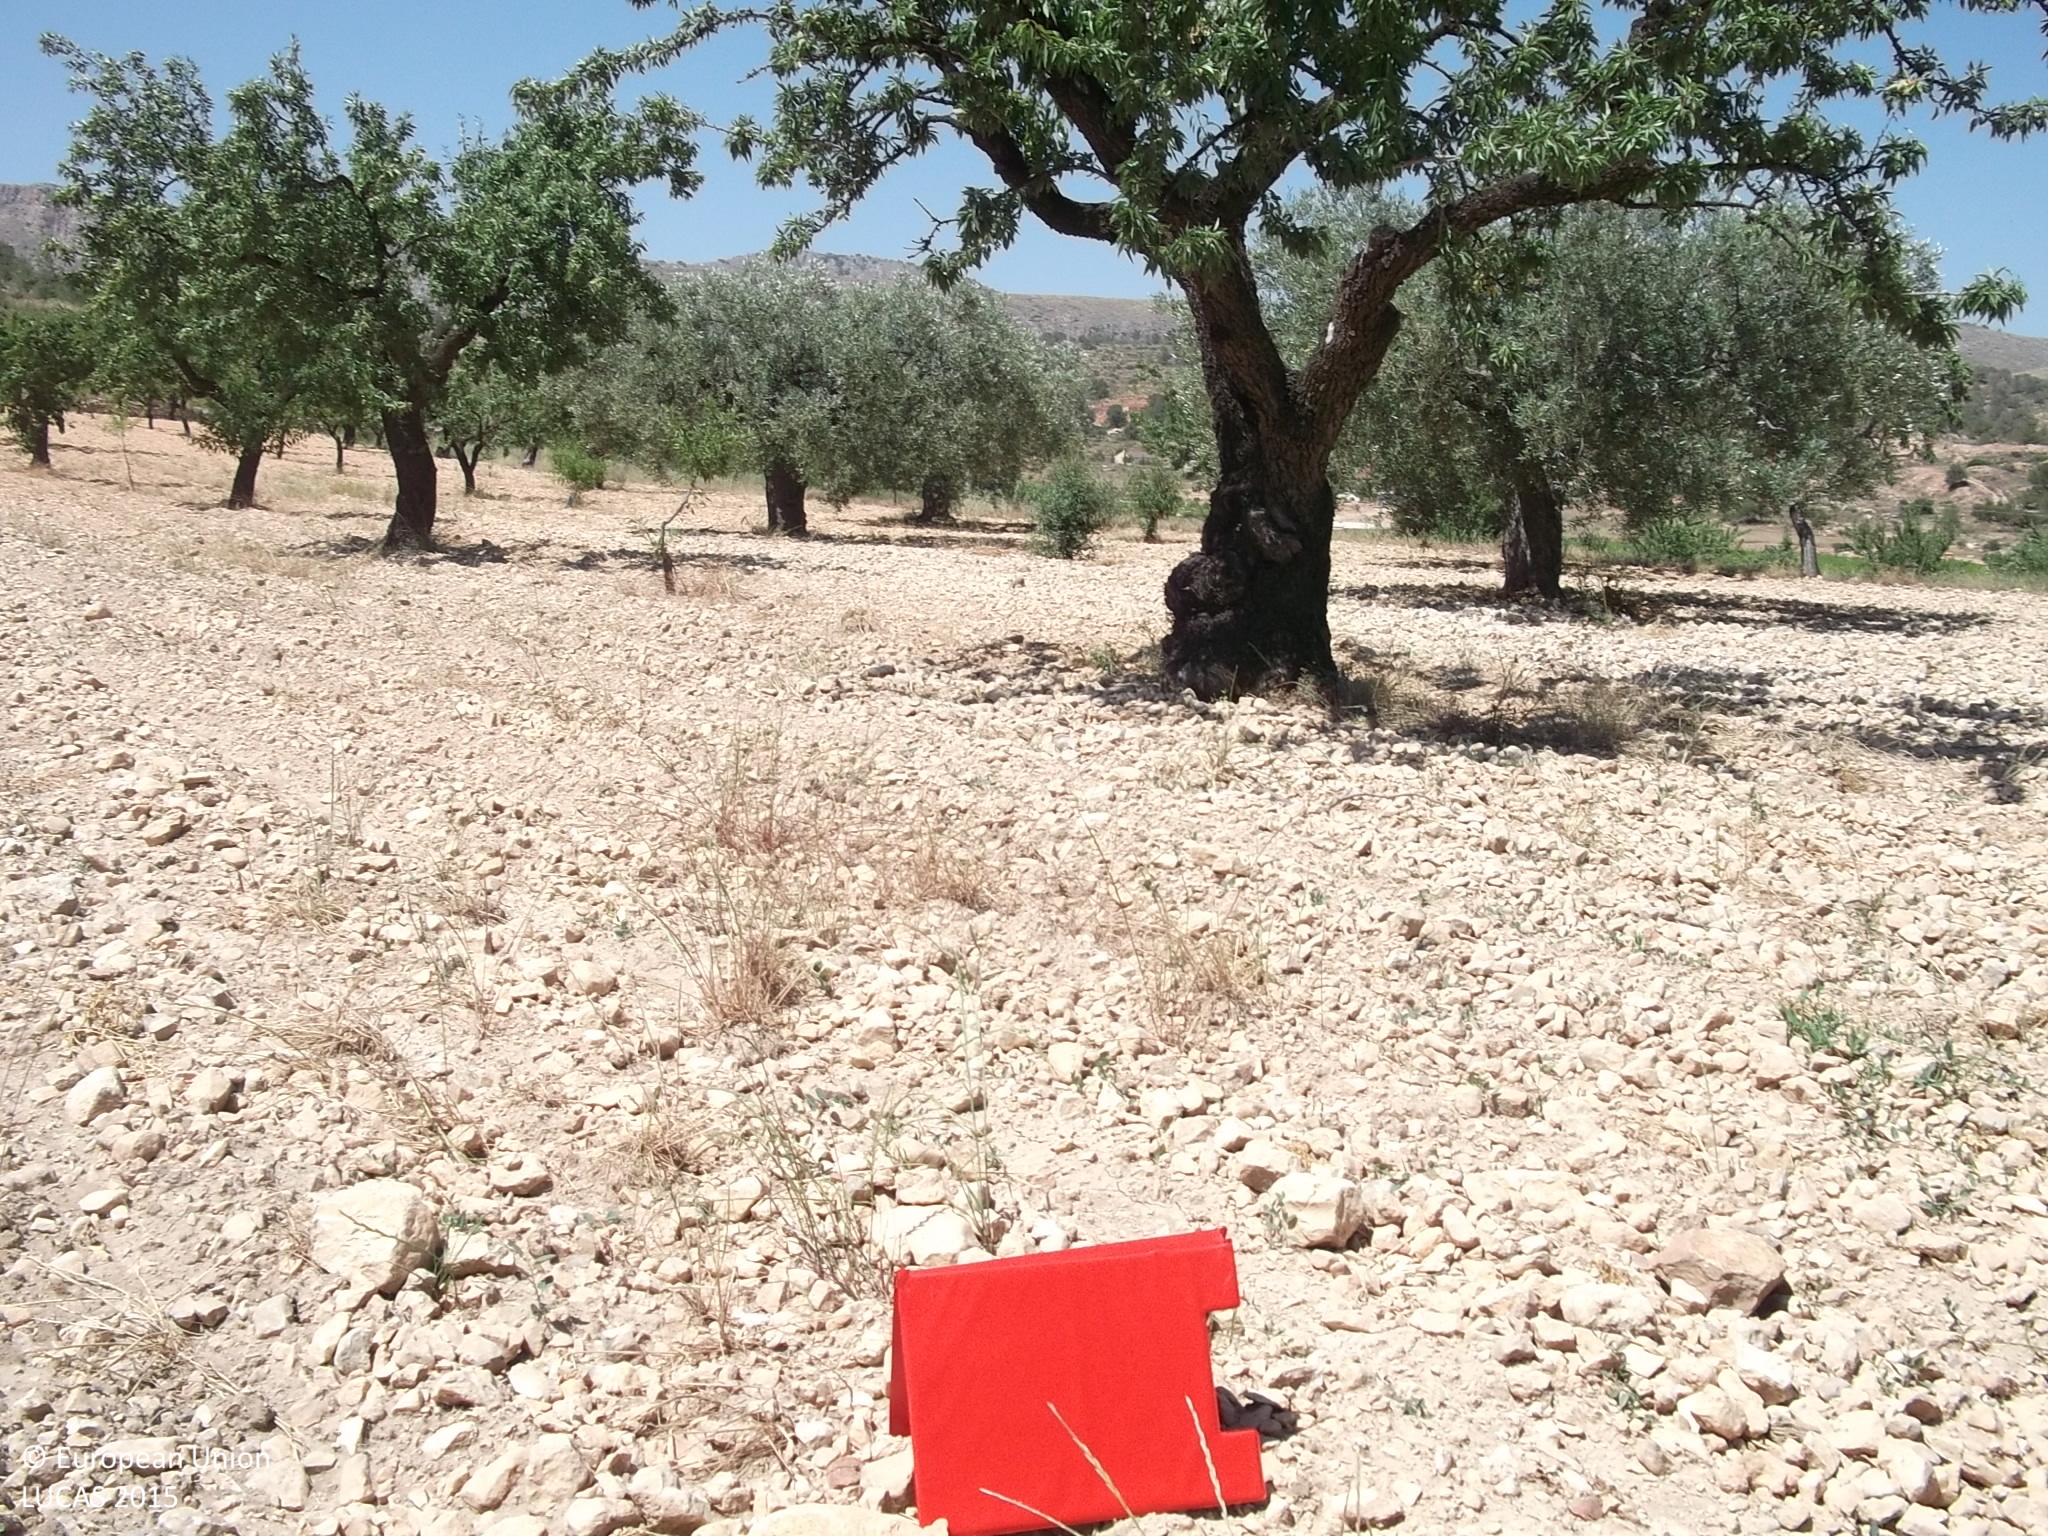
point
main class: Cropland
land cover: Nuts trees
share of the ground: 10 - 25 %
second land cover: Other bare soil
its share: > 75 %
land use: Agriculture (excluding fallow land and kitchen gardens)
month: May
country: ES
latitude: 38.3421
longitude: -0.9137
